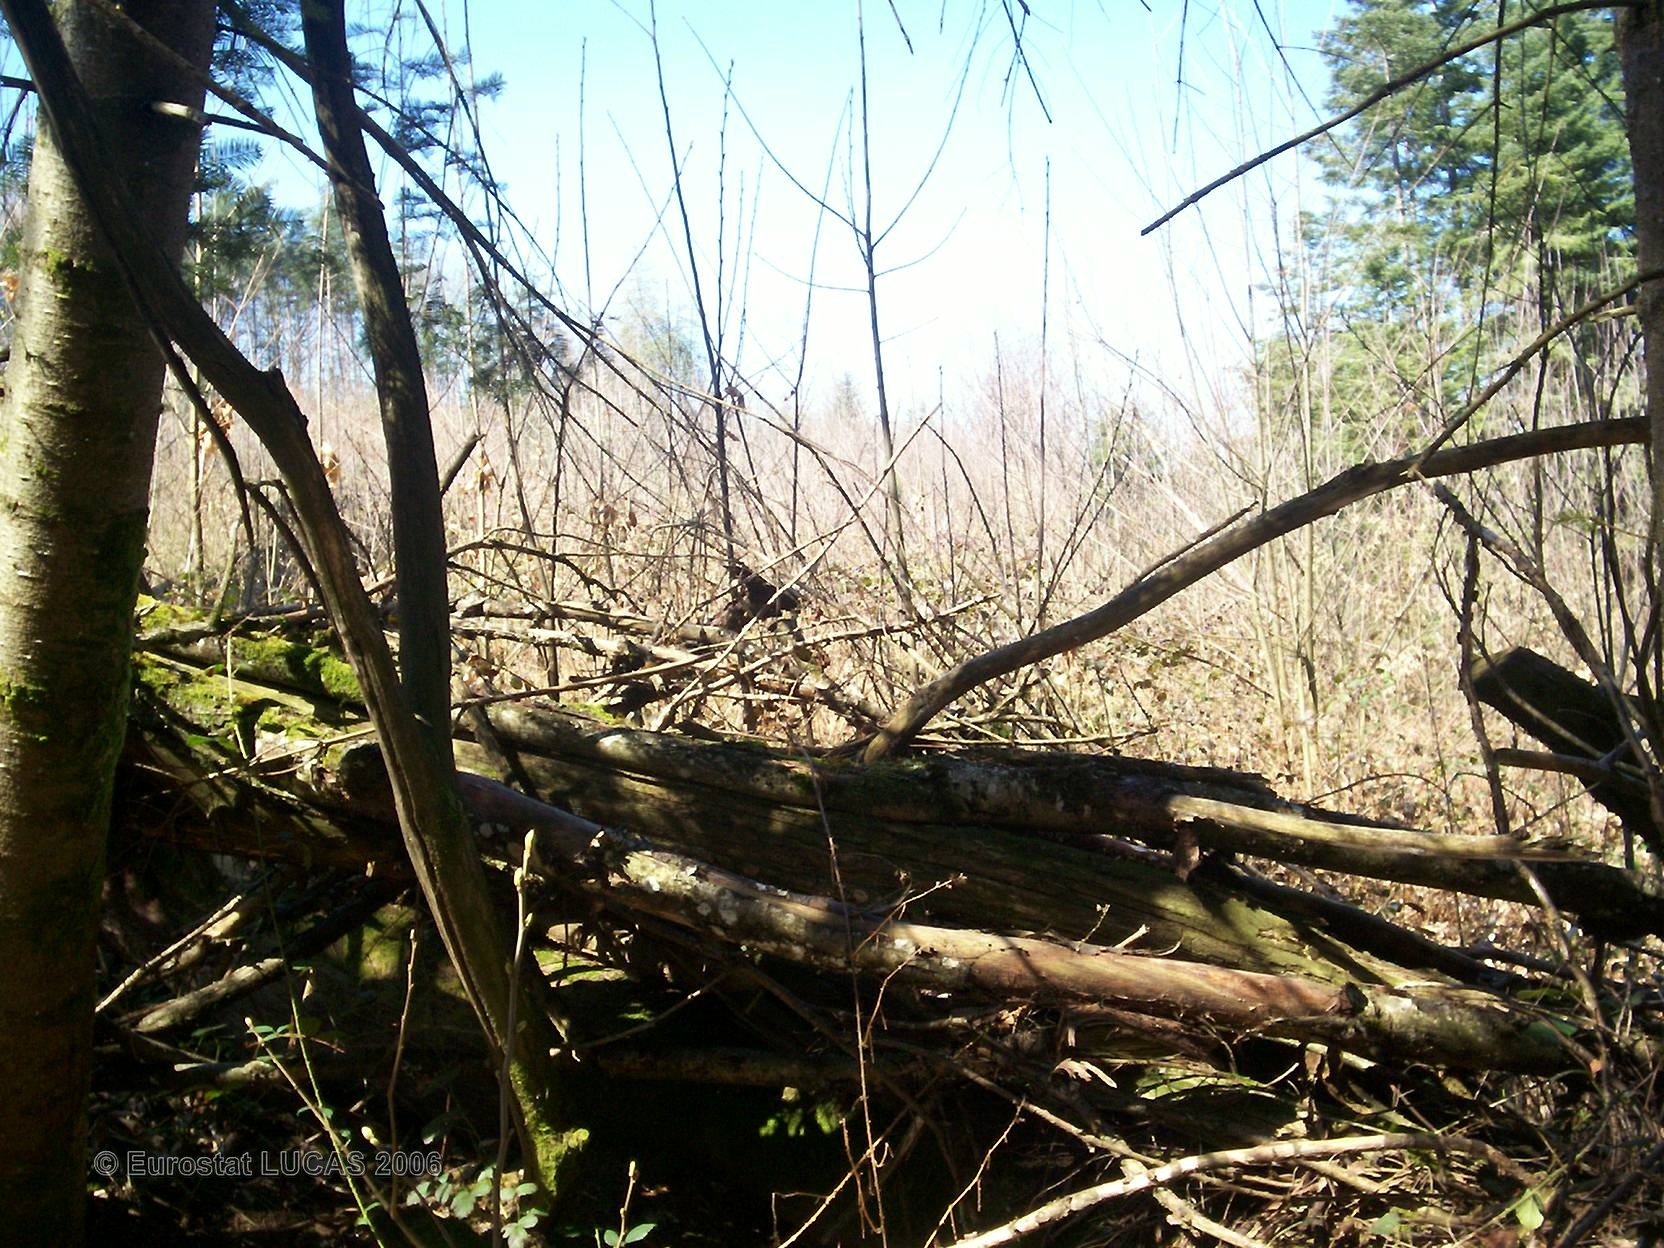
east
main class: Woodland
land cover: Mixed forest
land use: Forestry
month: April
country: FR
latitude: 45.3889
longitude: 1.6288
